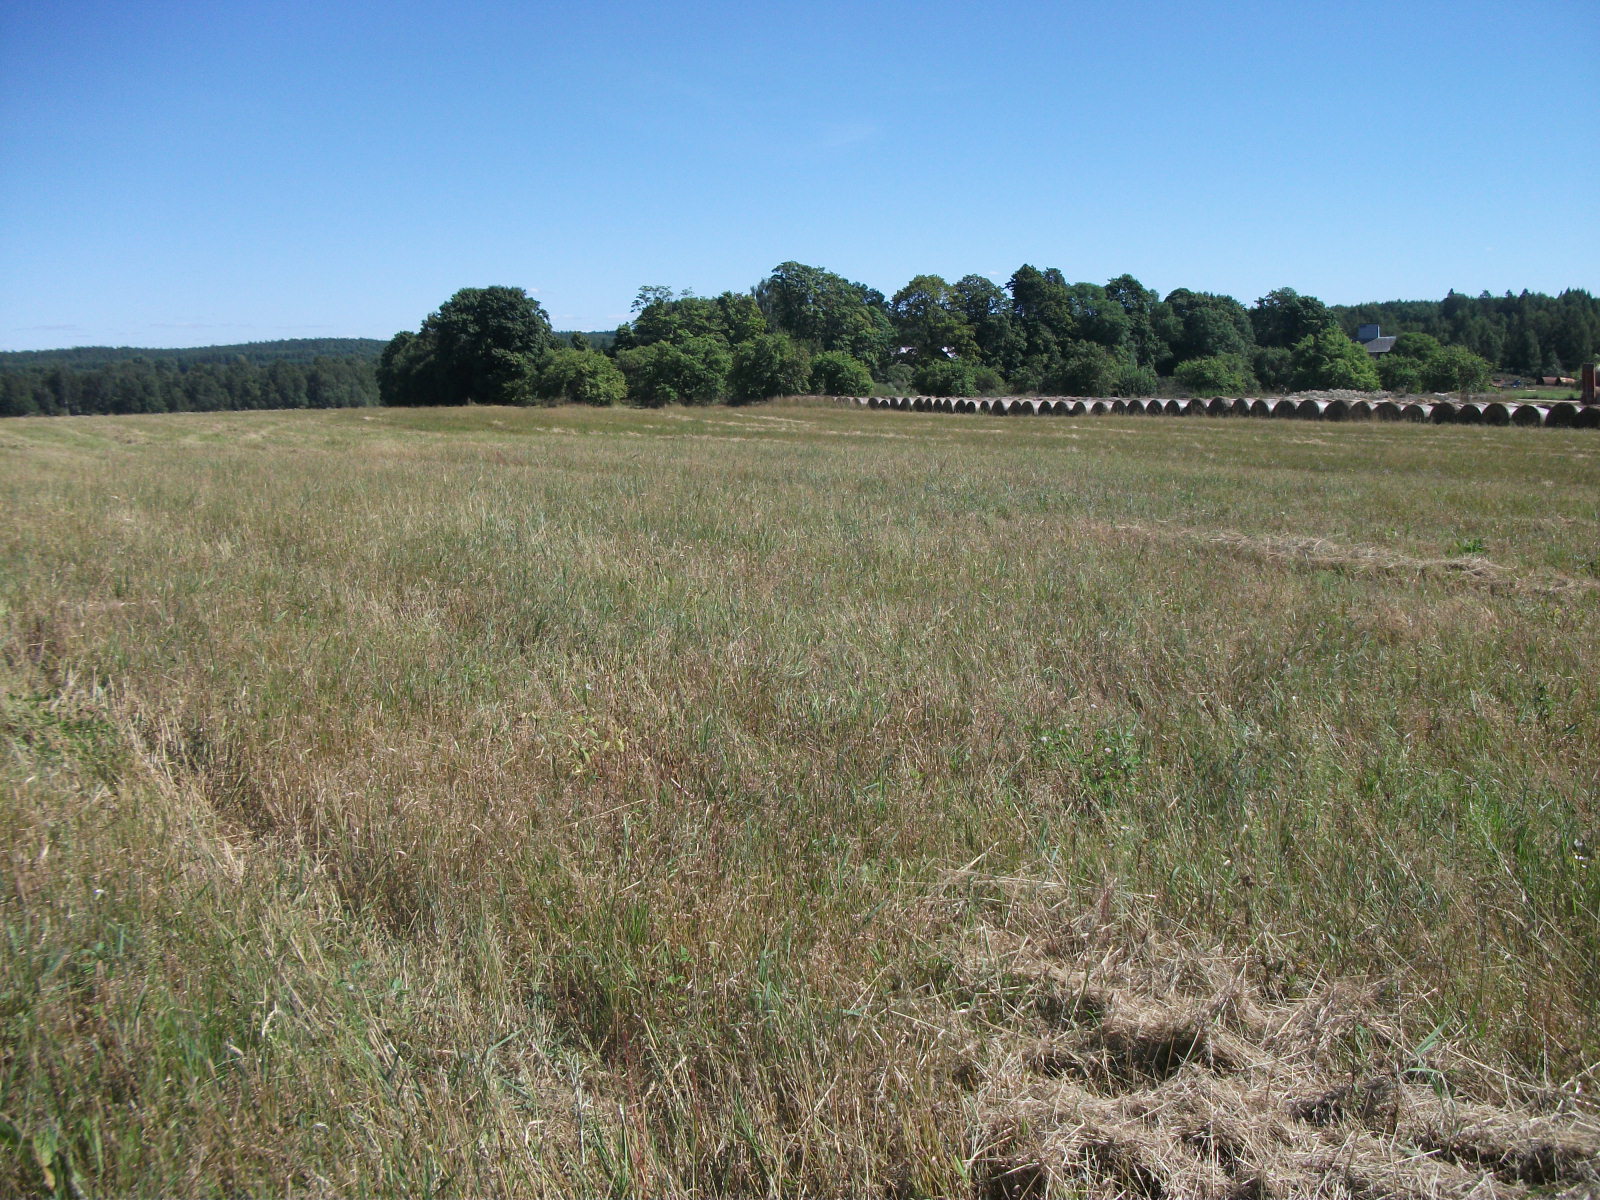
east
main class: Grassland
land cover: Grassland without tree/shrub cover
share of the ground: > 75 %
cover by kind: herbaceous plants 100 %
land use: Agriculture (excluding fallow land and kitchen gardens)
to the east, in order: Grassland without tree/shrub cover; Single bushes/trees; Grassland without tree/shrub cover; Apple fruit; Broadleaved woodland; Grassland without tree/shrub cover
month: August
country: LV
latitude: 56.6807
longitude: 26.1498
